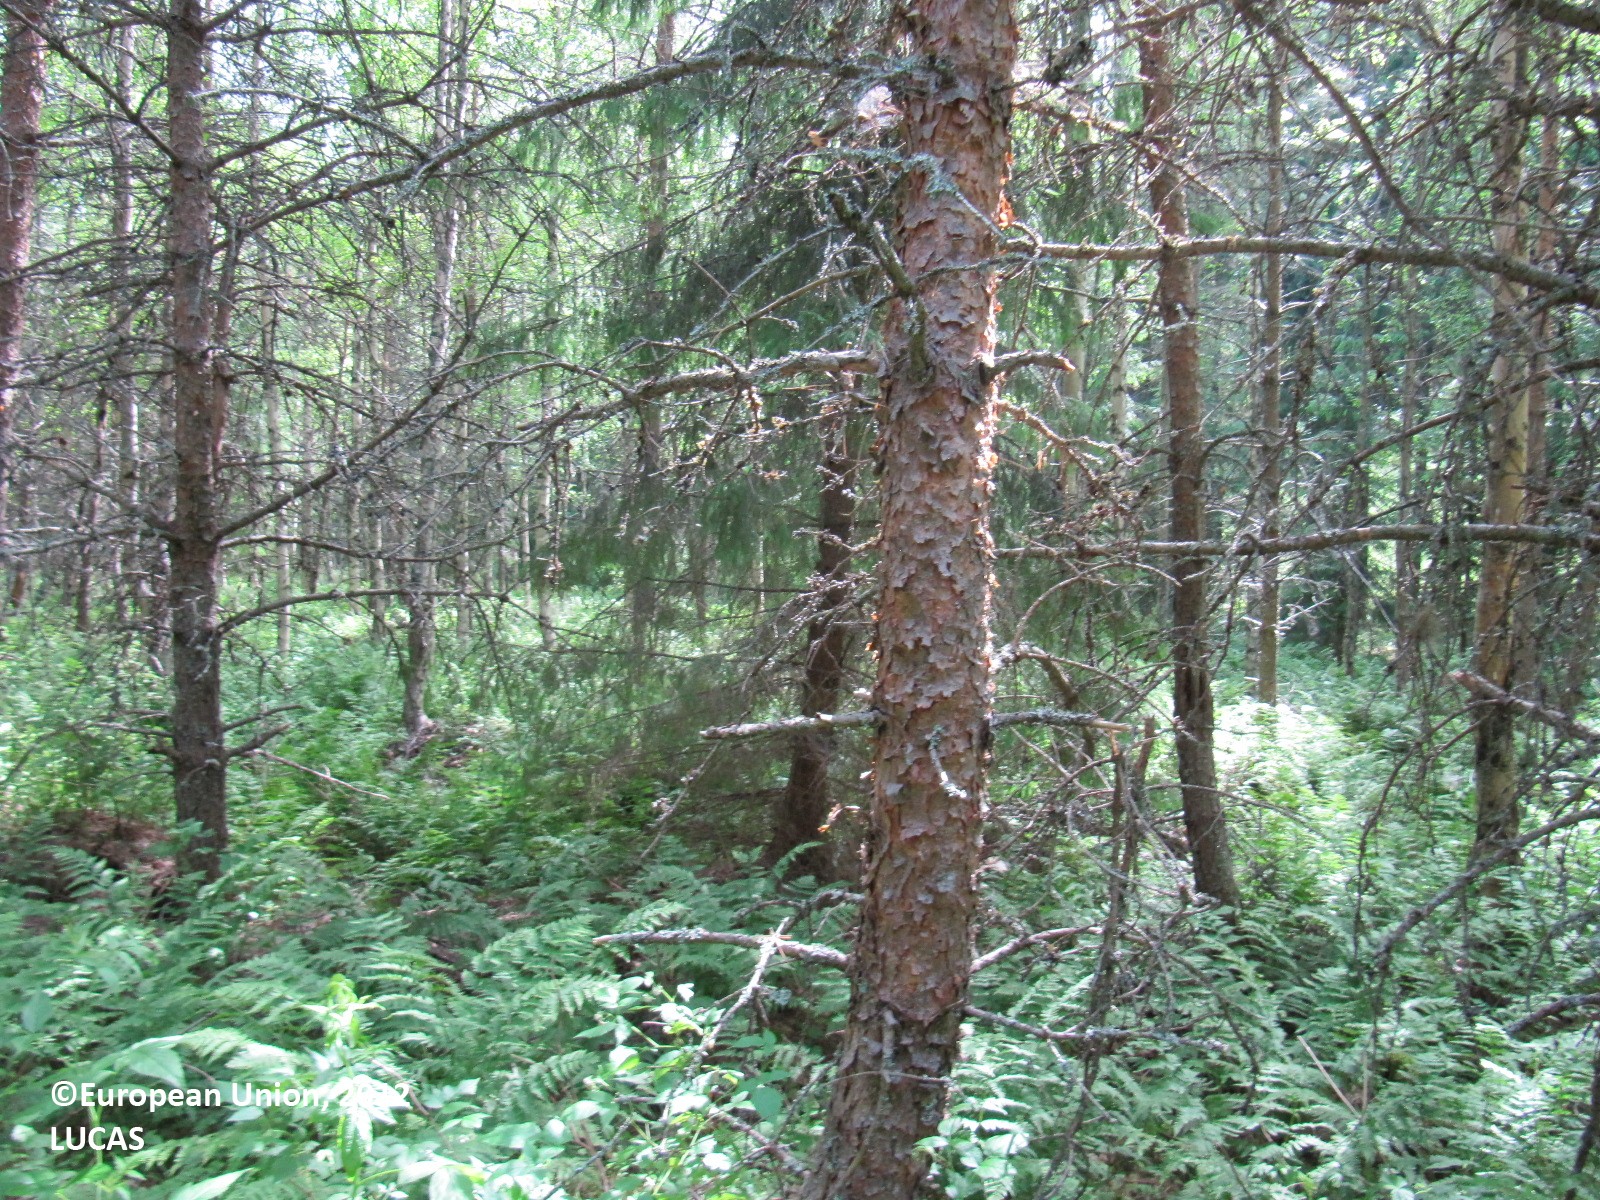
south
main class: Woodland
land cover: Spruce dominated mixed woodland
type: boreal forest
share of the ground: > 75 %
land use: Forestry
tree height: > 5 m
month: July
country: FI
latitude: 60.8806
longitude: 23.3262
